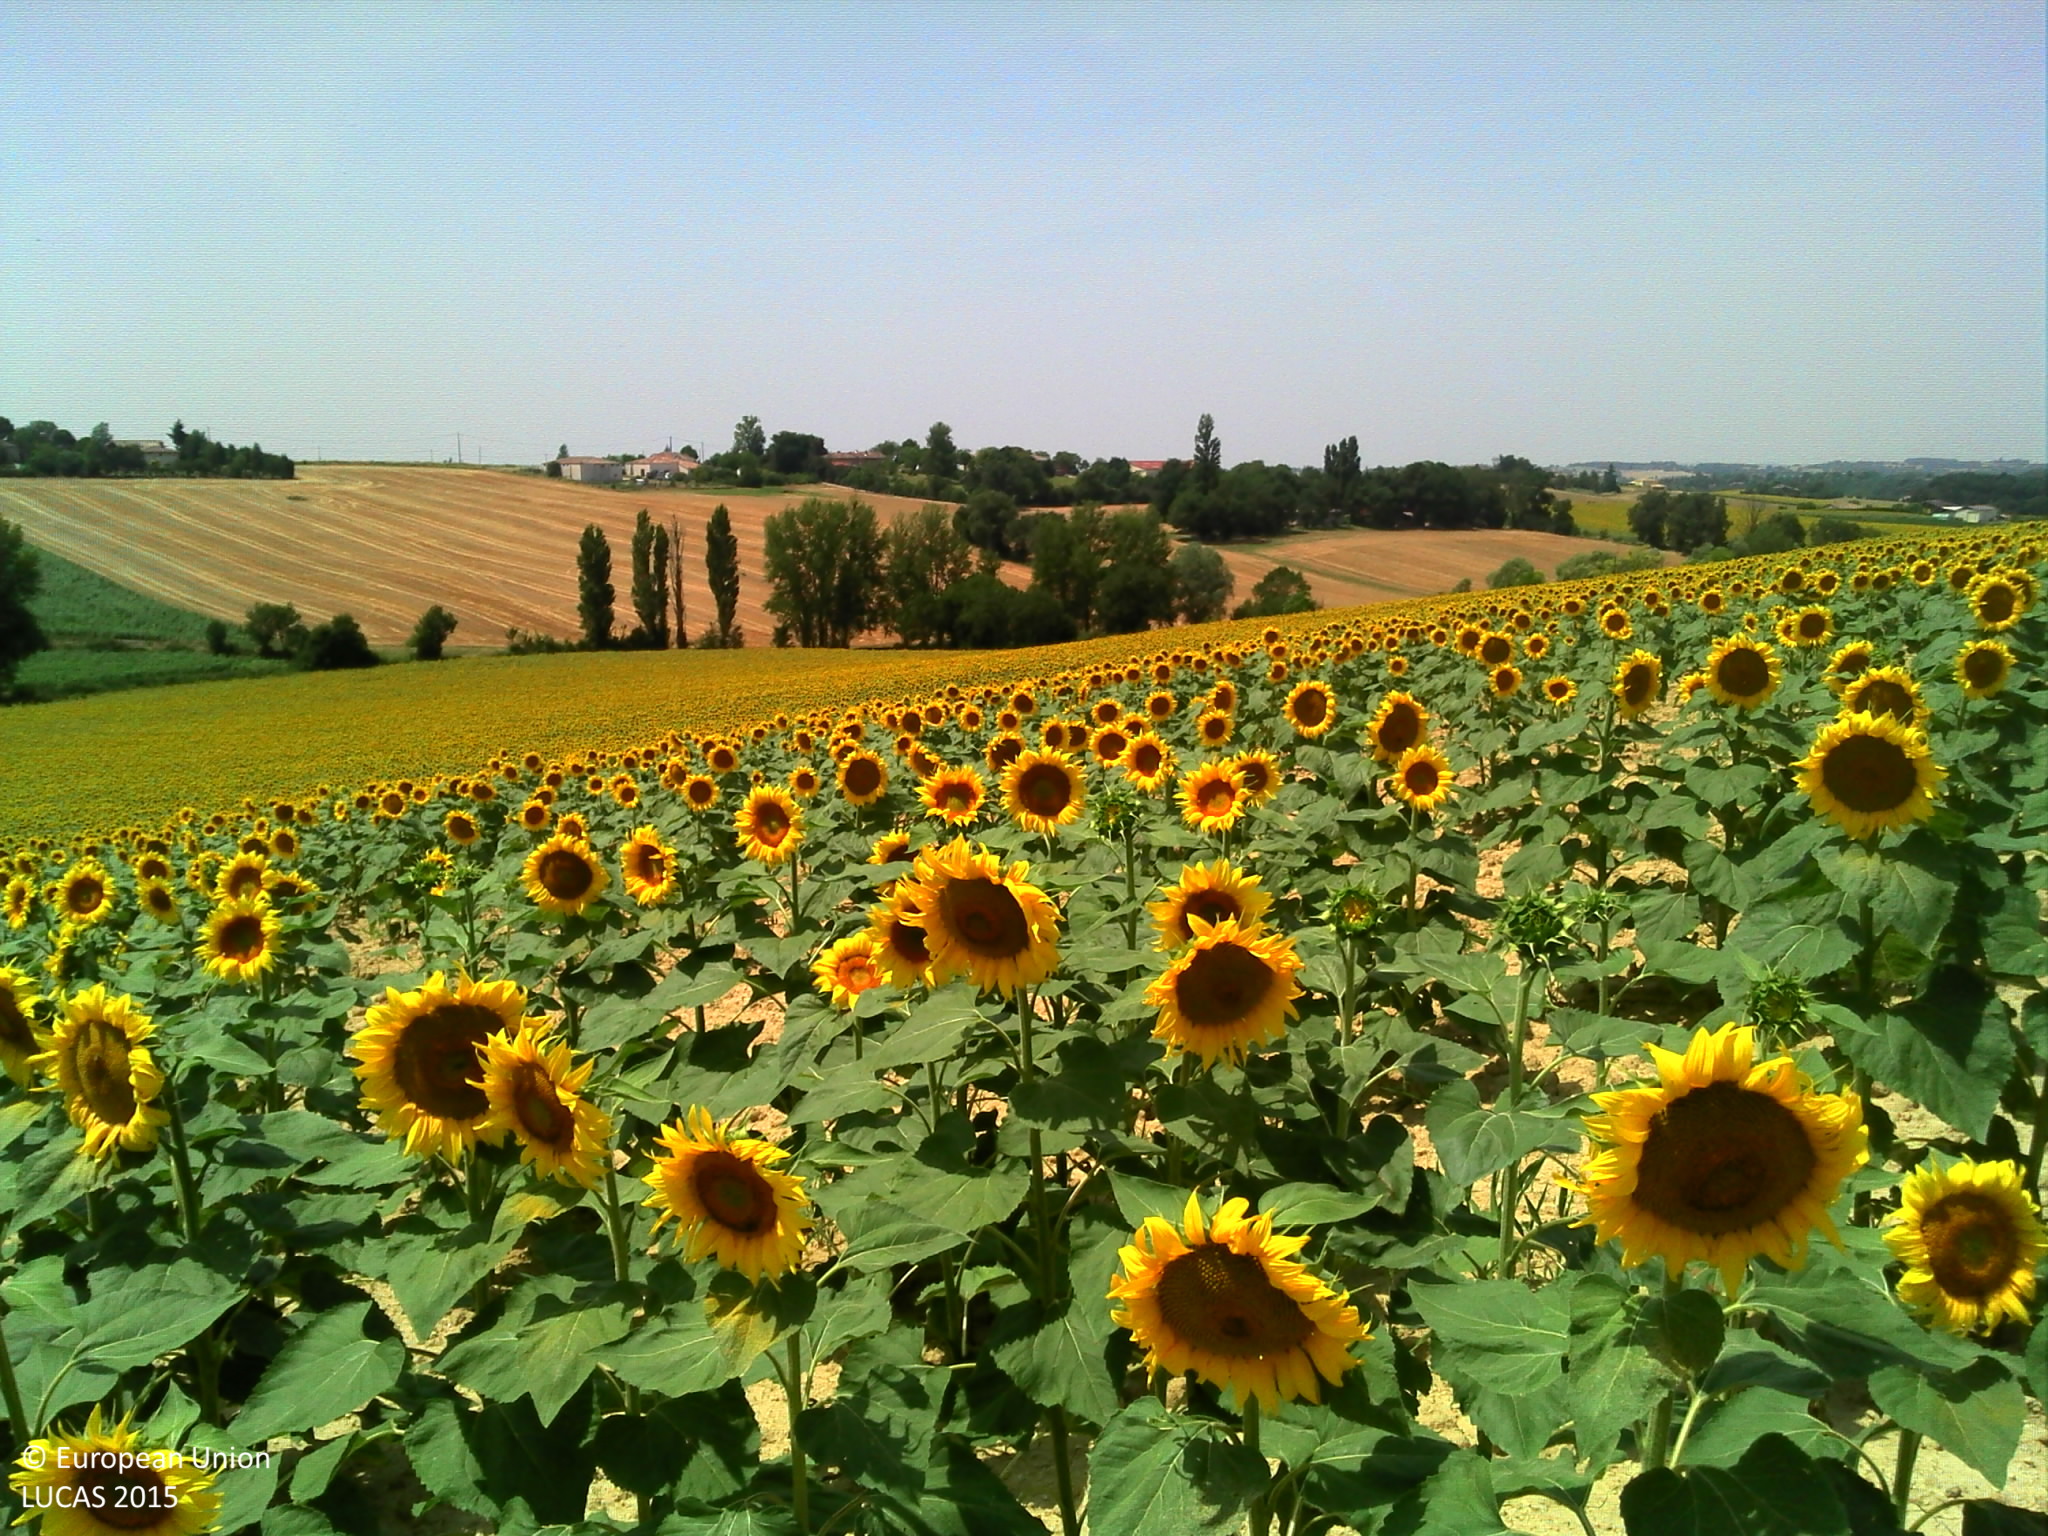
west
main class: Cropland
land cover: Sunflower
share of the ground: > 75 %
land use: Agriculture (excluding fallow land and kitchen gardens)
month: July
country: FR
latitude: 43.6893
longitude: 1.0303
